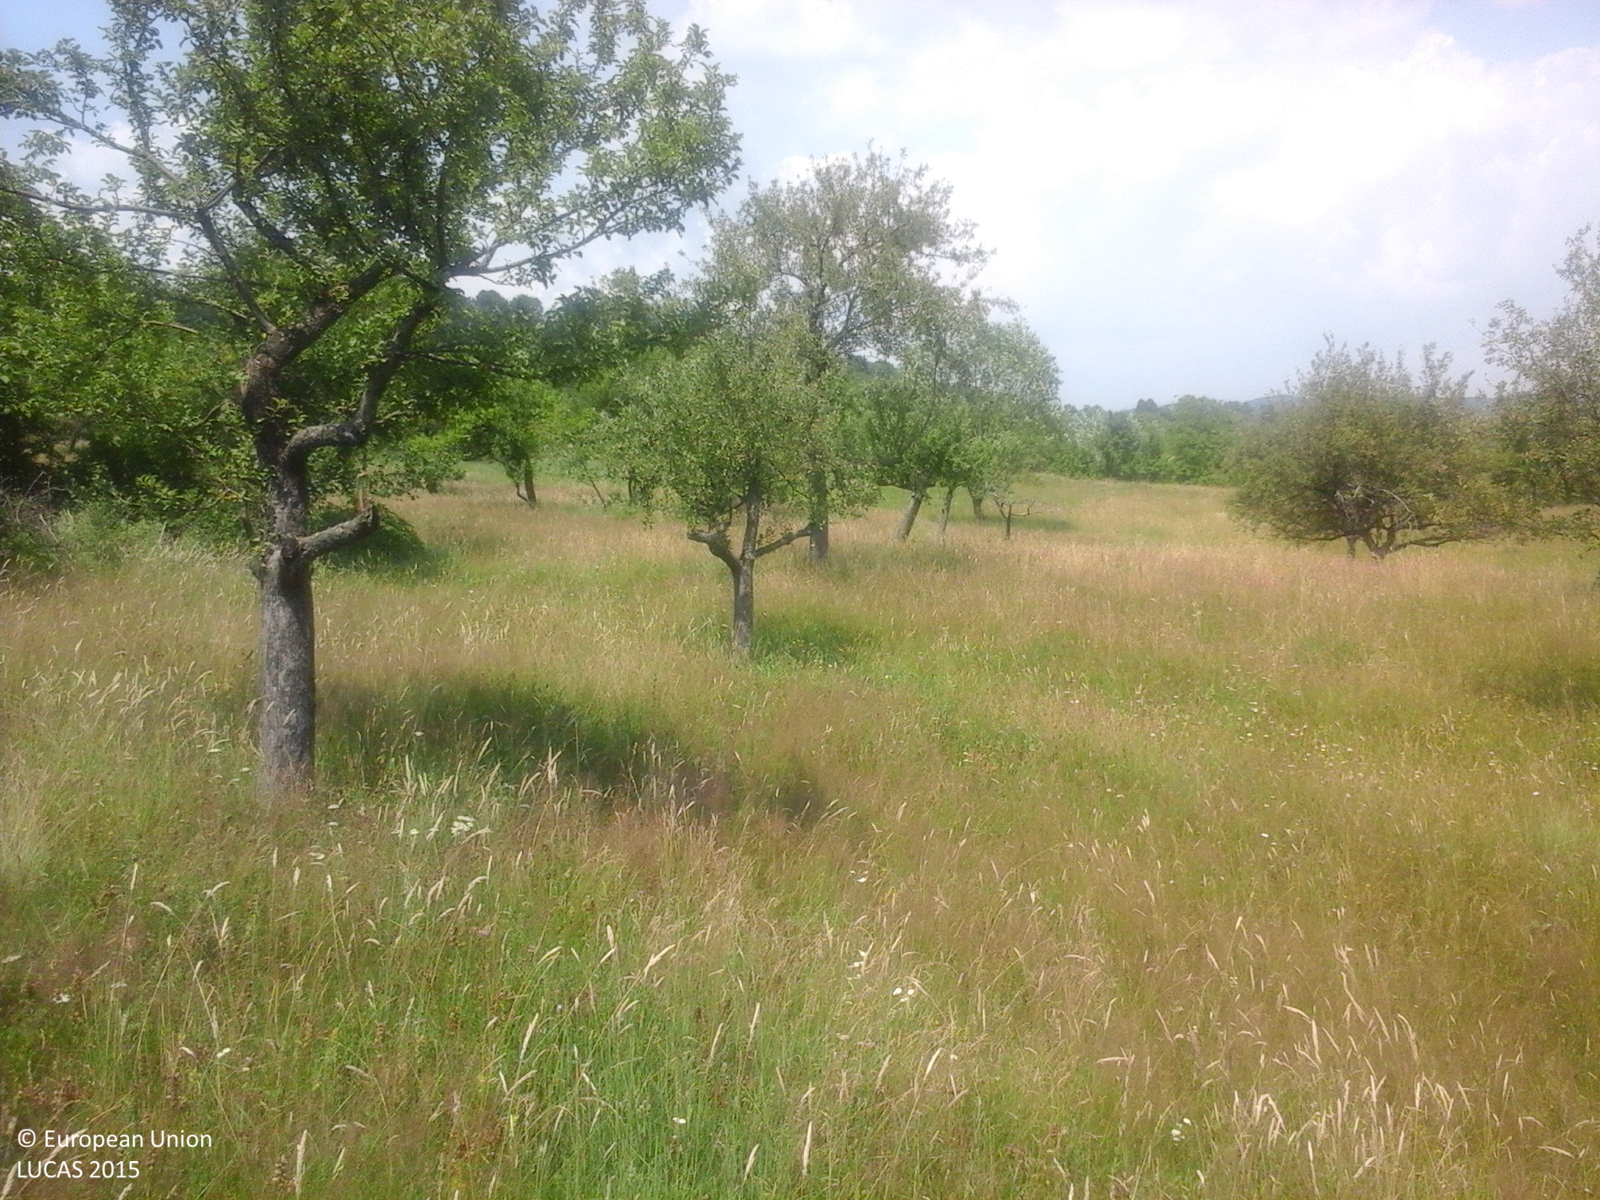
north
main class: Cropland
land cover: Apple fruit
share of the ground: 50 - 75 %
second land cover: Grassland without tree/shrub cover
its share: > 75 %
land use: Agriculture (excluding fallow land and kitchen gardens)
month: July
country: RO
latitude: 45.2062
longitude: 24.9179
